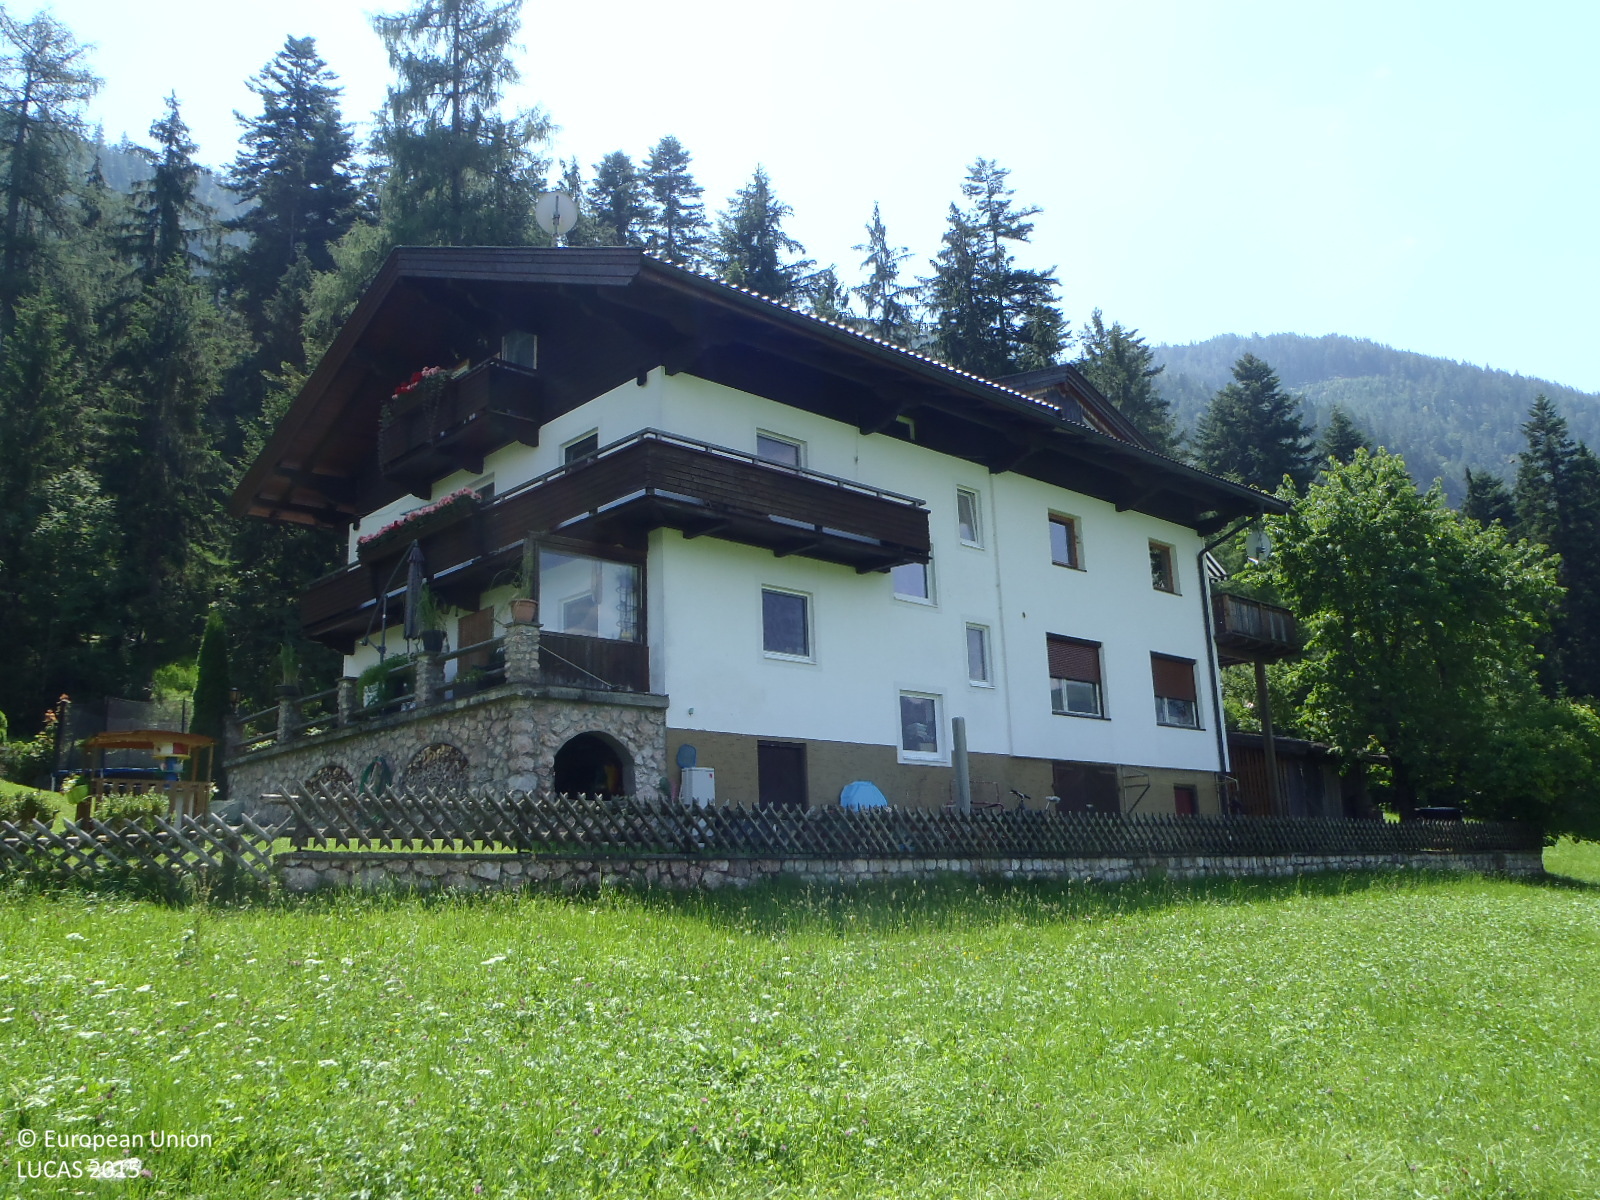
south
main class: Grassland
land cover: Grassland without tree/shrub cover
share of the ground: > 75 %
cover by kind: herbaceous plants 100 %
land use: Agriculture (excluding fallow land and kitchen gardens)
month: July
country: AT
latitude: 47.4871
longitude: 11.8964
